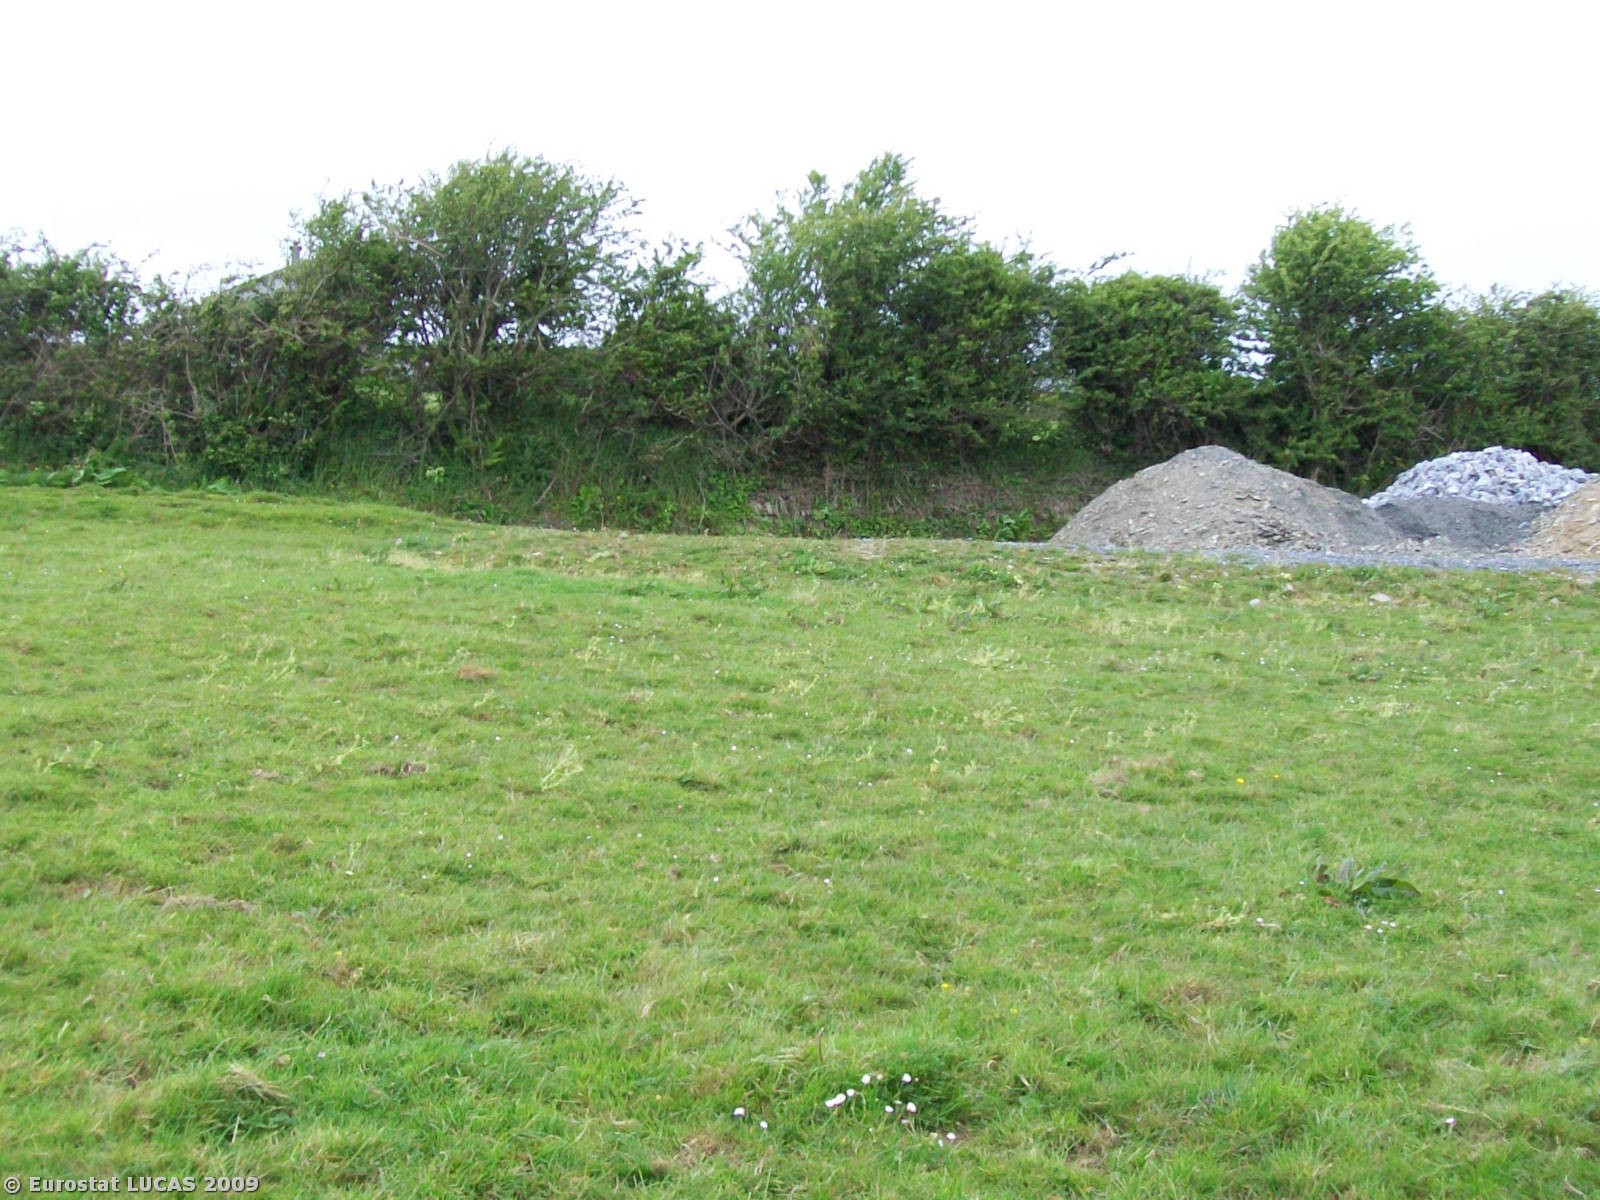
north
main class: Cropland
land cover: Common wheat
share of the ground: > 75 %
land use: Agriculture (excluding fallow land and kitchen gardens)
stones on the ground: < 10 %
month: May
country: IE
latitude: 51.7110
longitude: -8.6522
